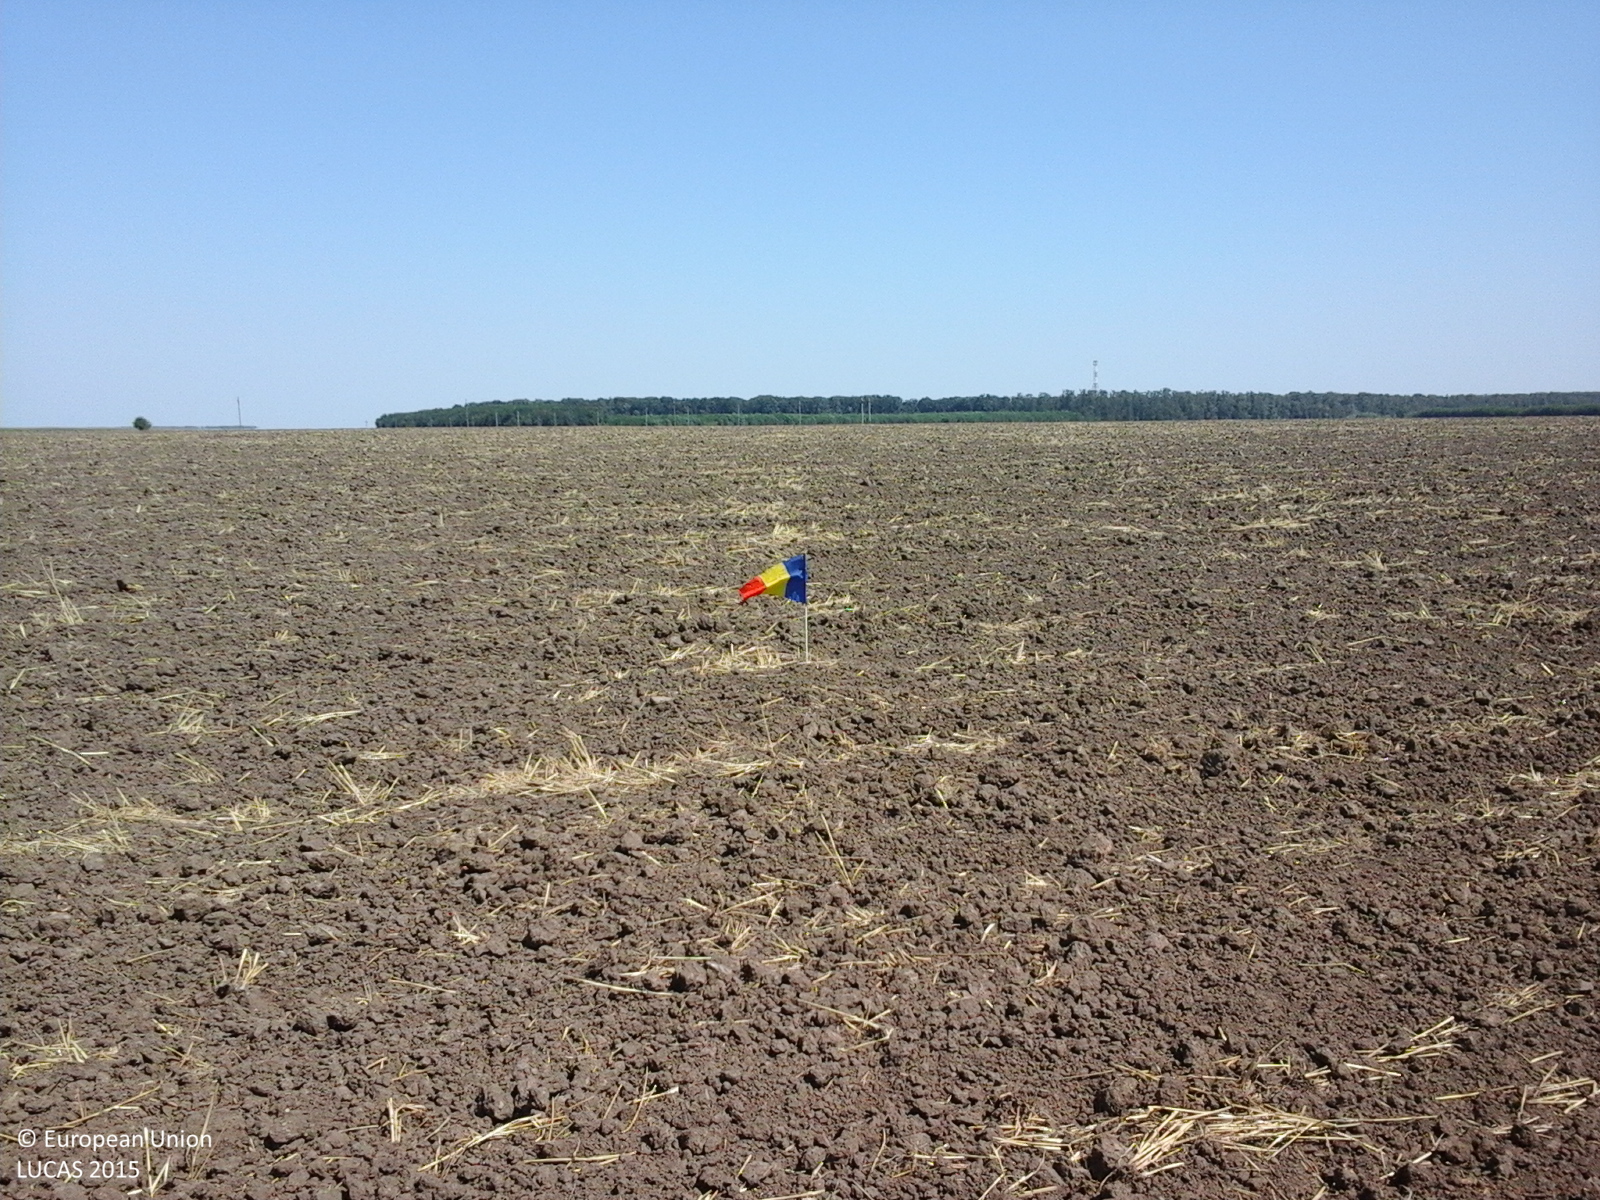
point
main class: Cropland
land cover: Common wheat
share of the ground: < 10 %
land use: Agriculture (excluding fallow land and kitchen gardens)
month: July
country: RO
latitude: 44.3367
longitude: 26.5323
